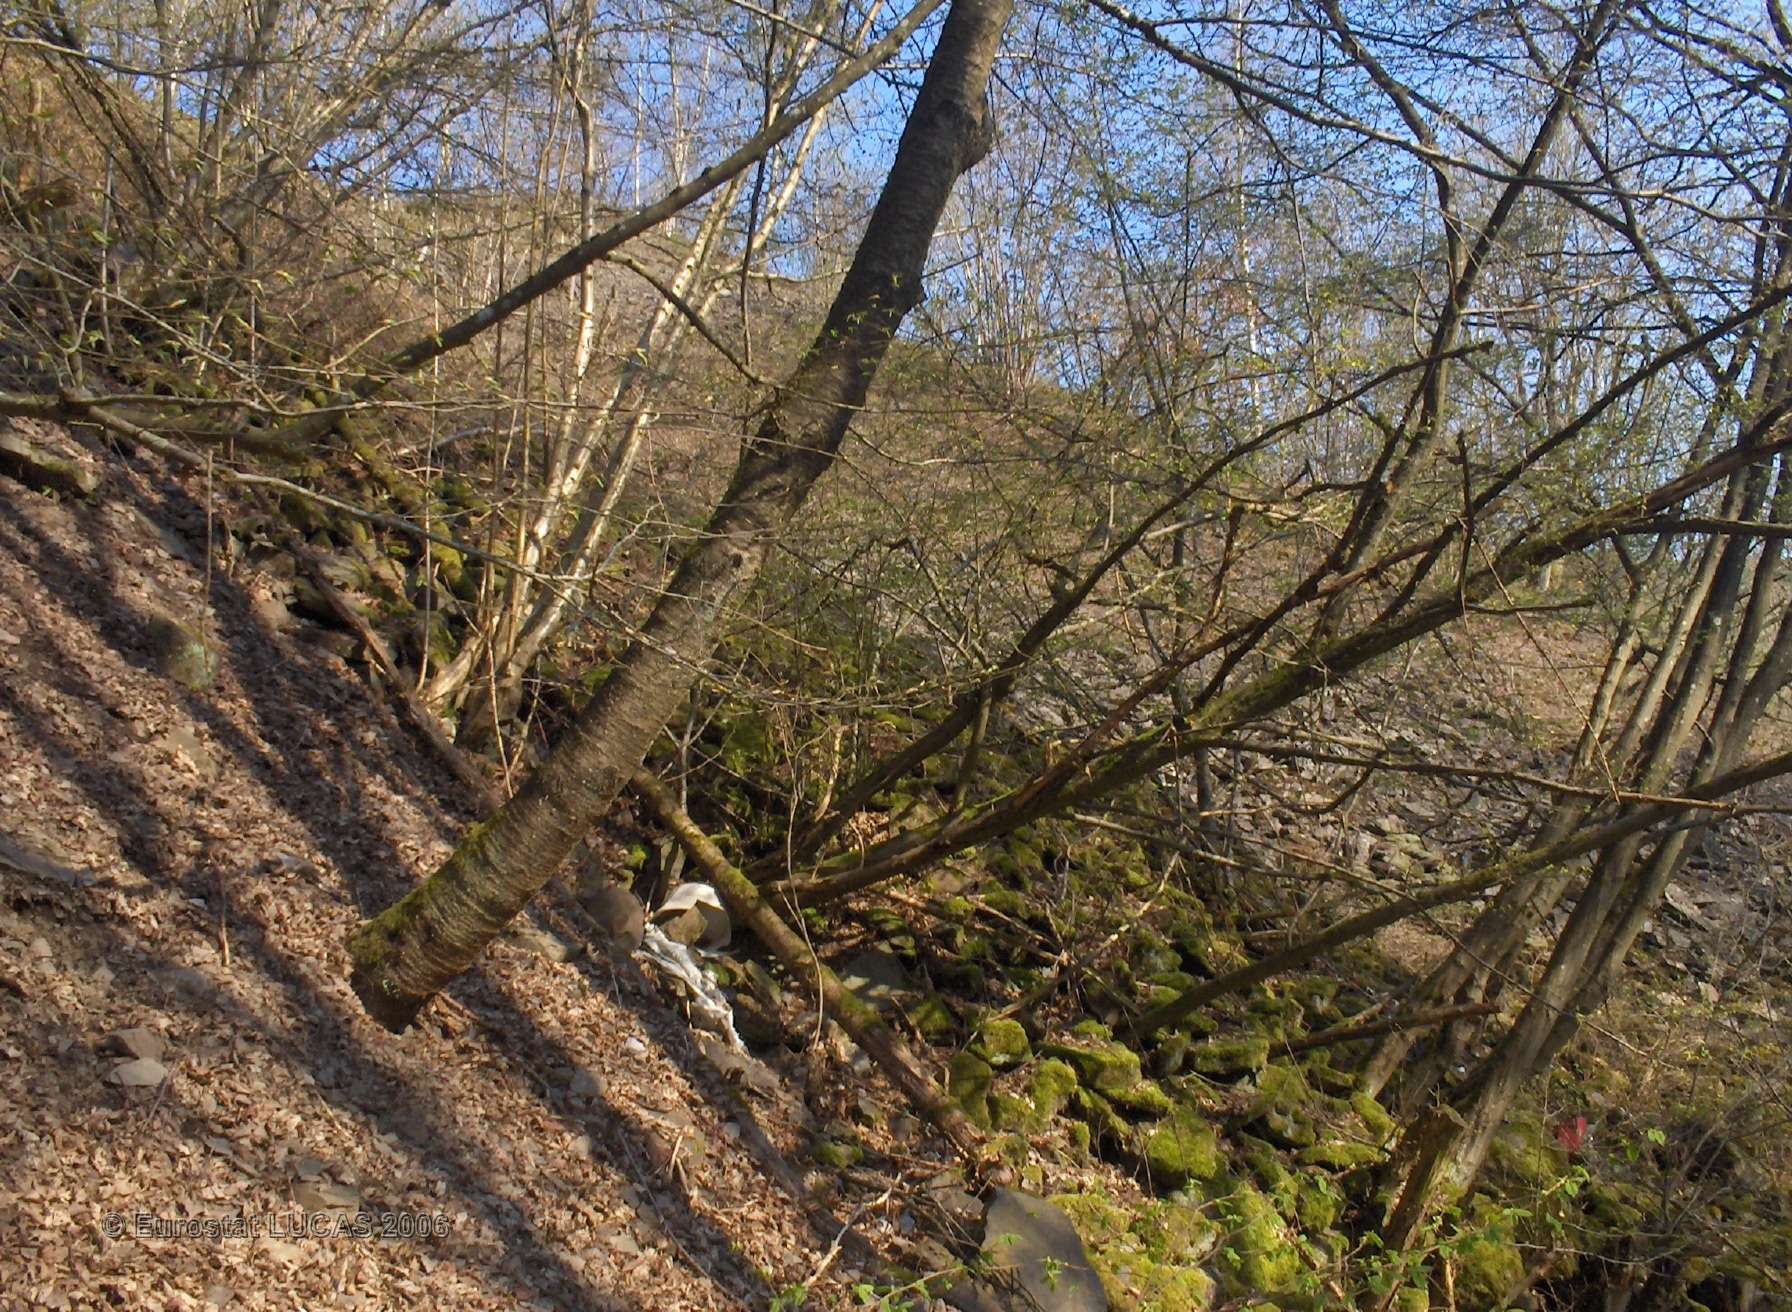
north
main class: Woodland
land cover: Broadleaved forest
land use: Forestry
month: April
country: BE
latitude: 50.0559
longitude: 4.5909
